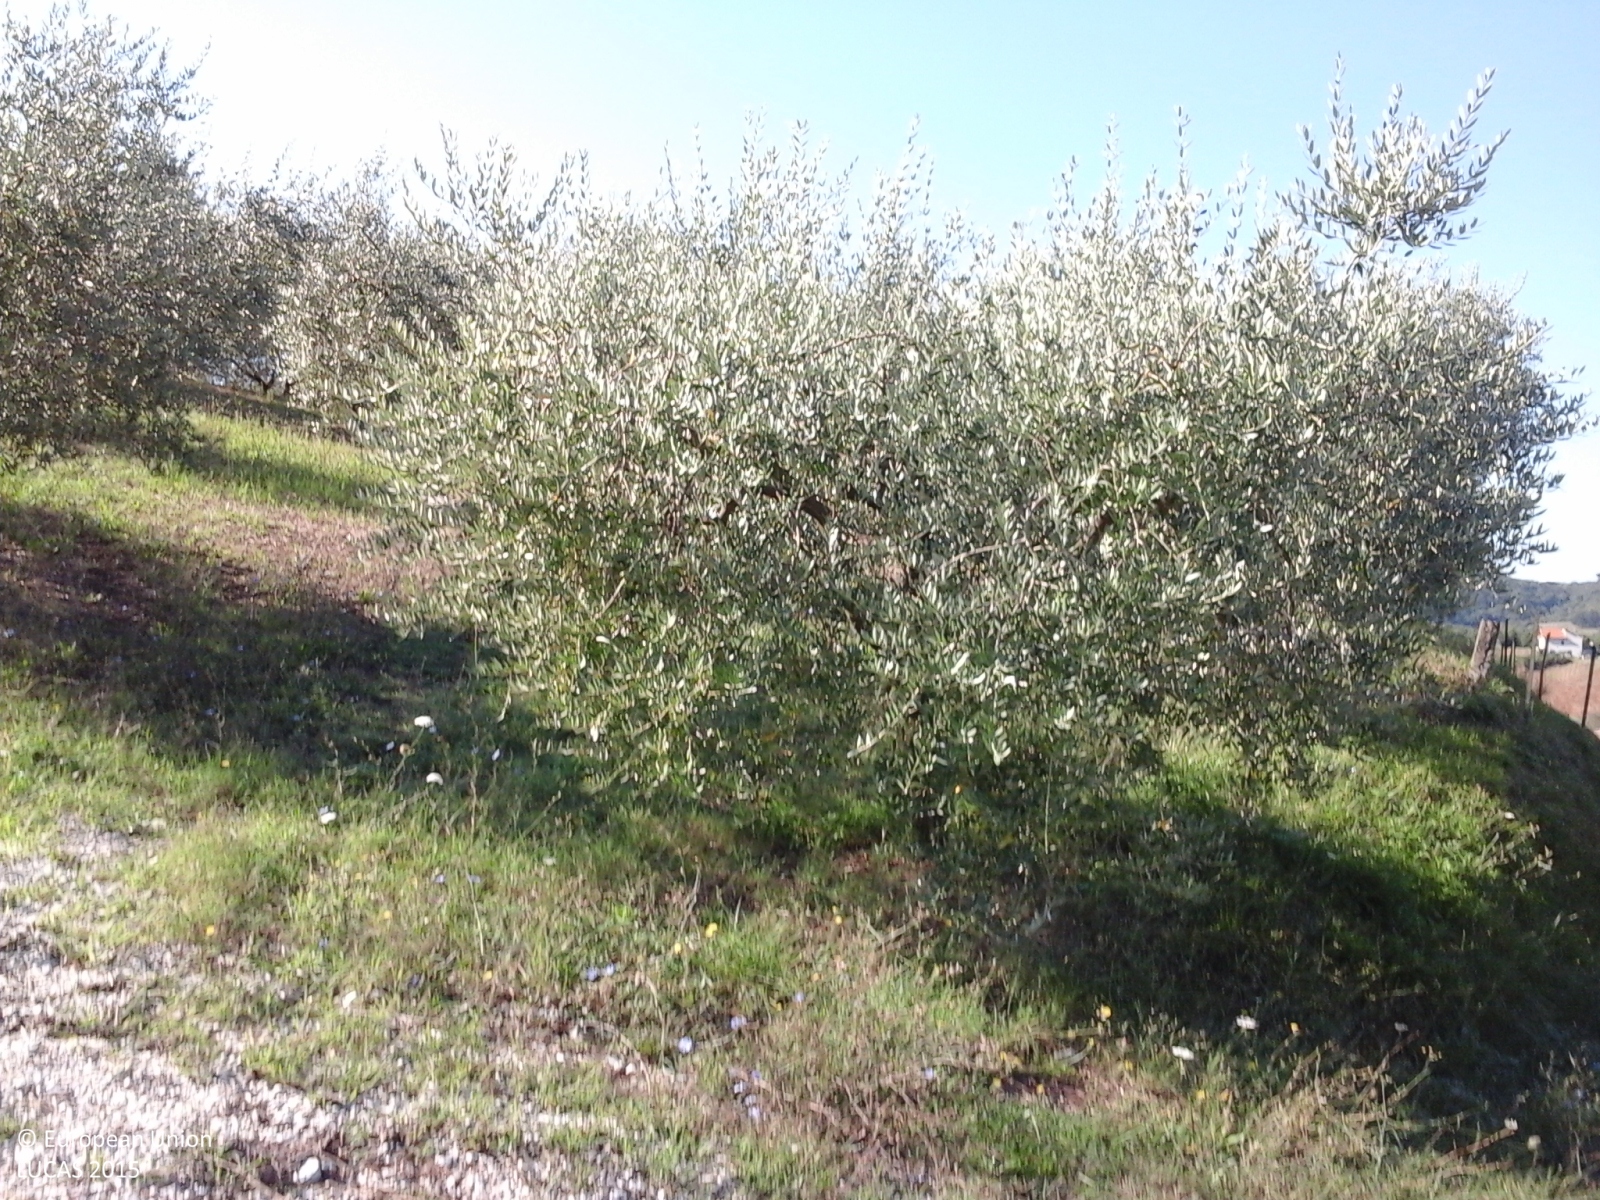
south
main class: Cropland
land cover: Olive groves
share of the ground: 25 - 50 %
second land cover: Grassland without tree/shrub cover
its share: > 75 %
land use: Agriculture (excluding fallow land and kitchen gardens)
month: August
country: IT
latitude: 41.9452
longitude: 12.8484
